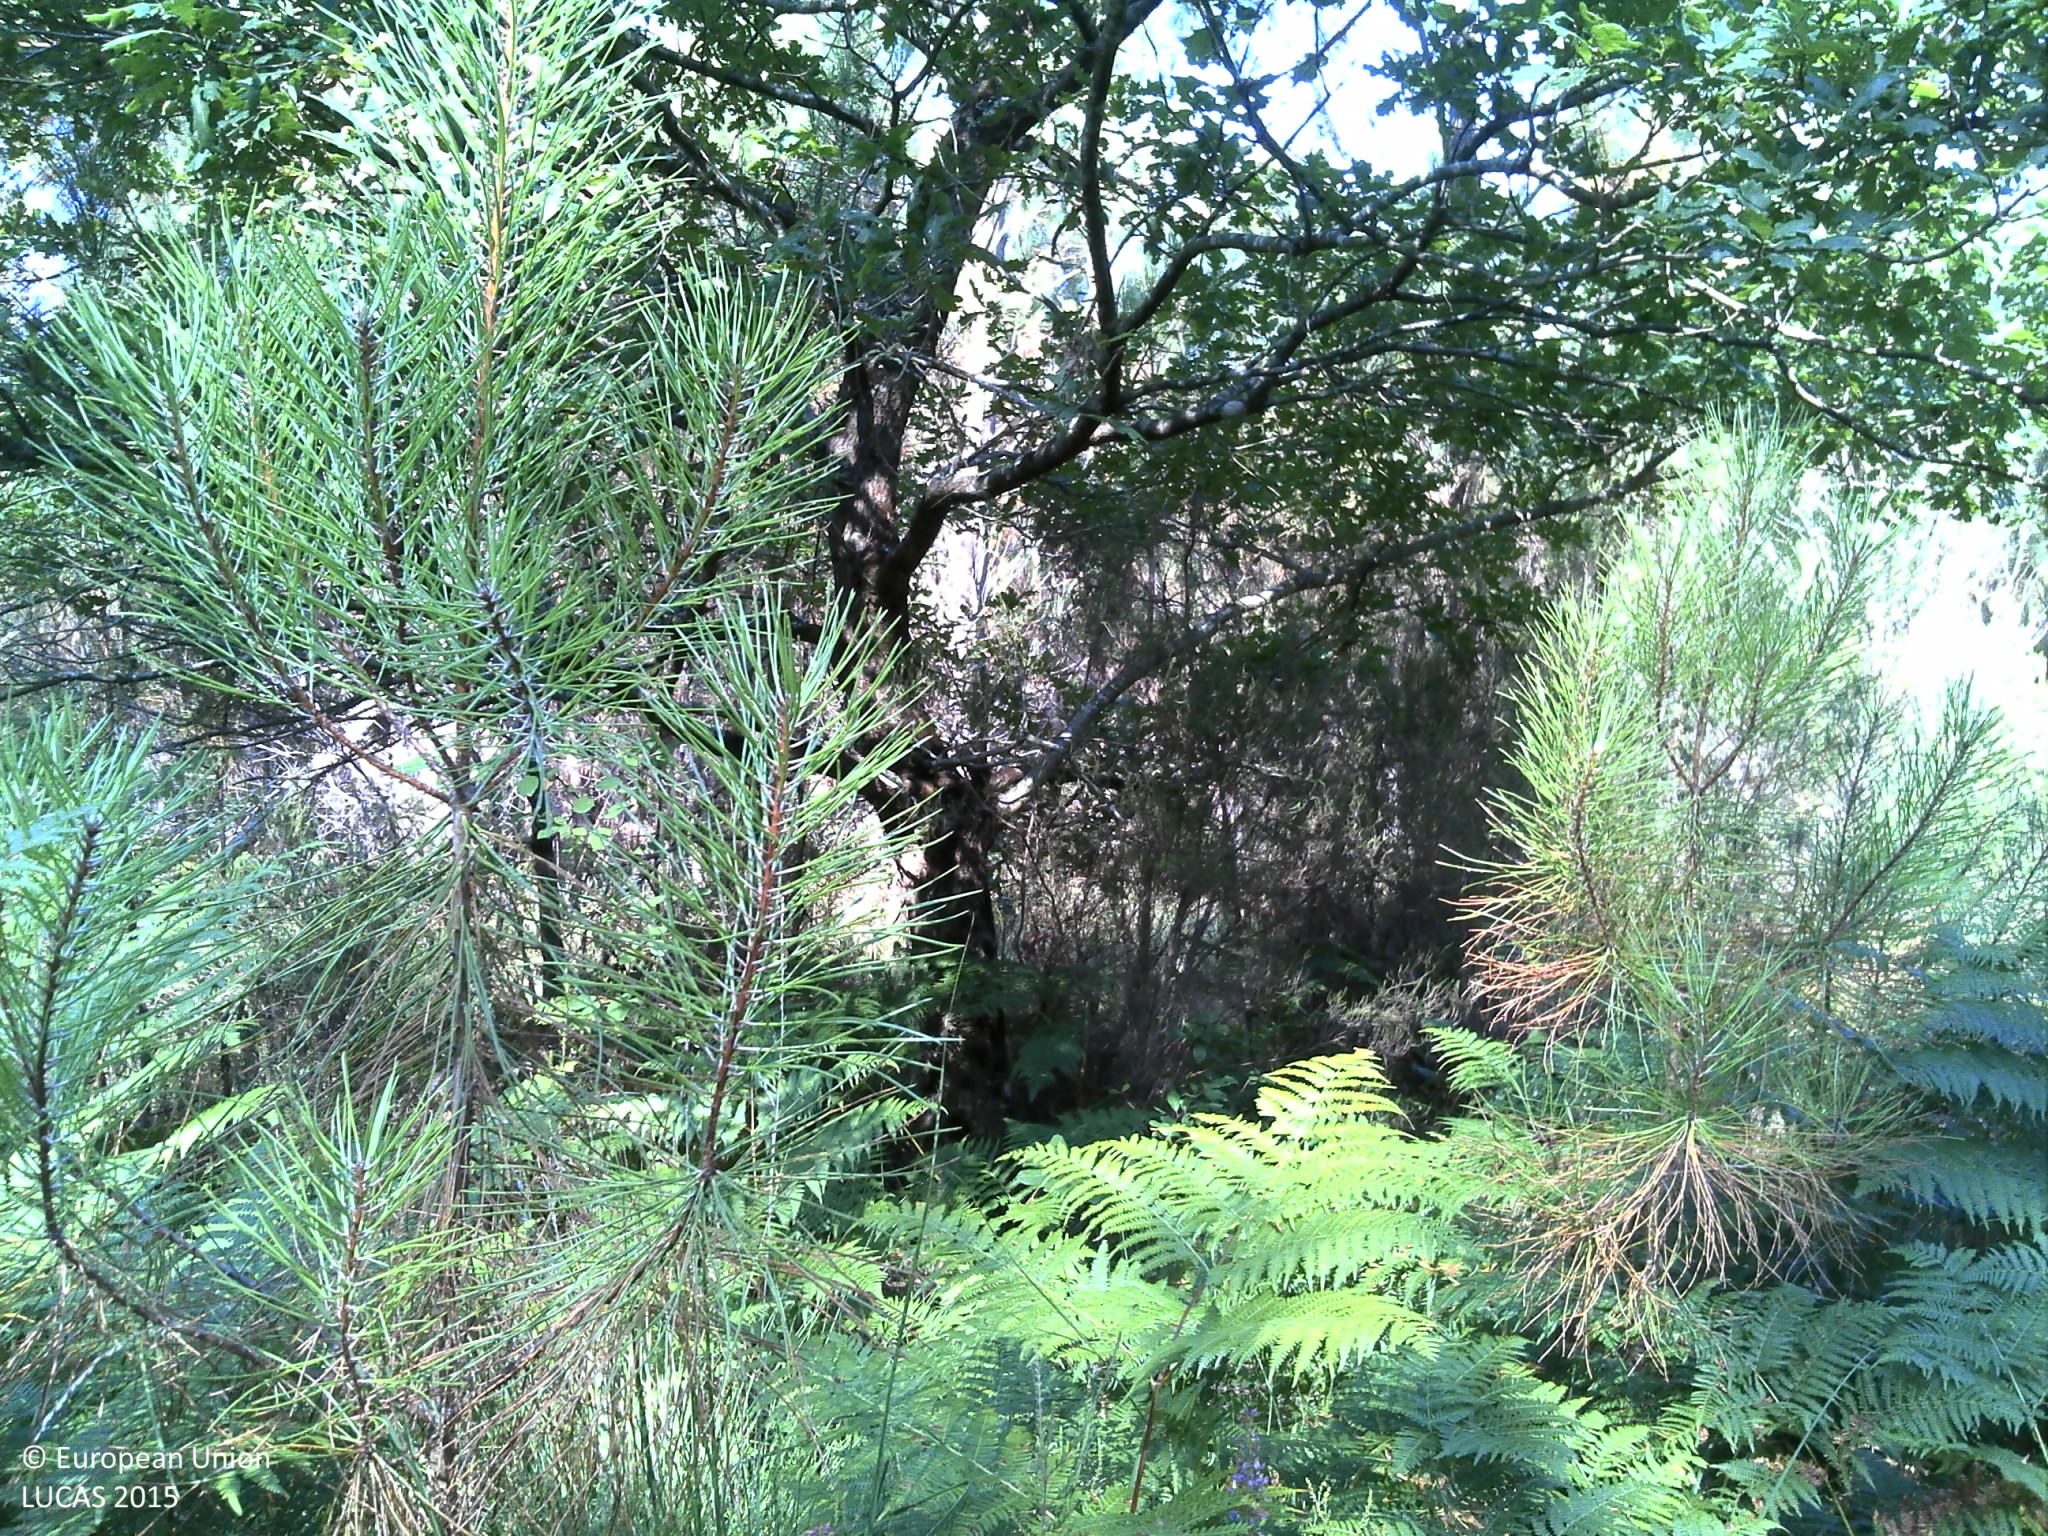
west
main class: Woodland
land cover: Pine dominated coniferous woodland
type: coniferous forest of the mediterranean region
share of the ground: > 75 %
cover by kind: coniferous forest trees 60 %, shrubs 30 %, herbaceous plants 5 %, lichens and mosses 5 %
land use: Forestry
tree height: > 5 m
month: August
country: FR
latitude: 45.0569
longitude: -0.9826
